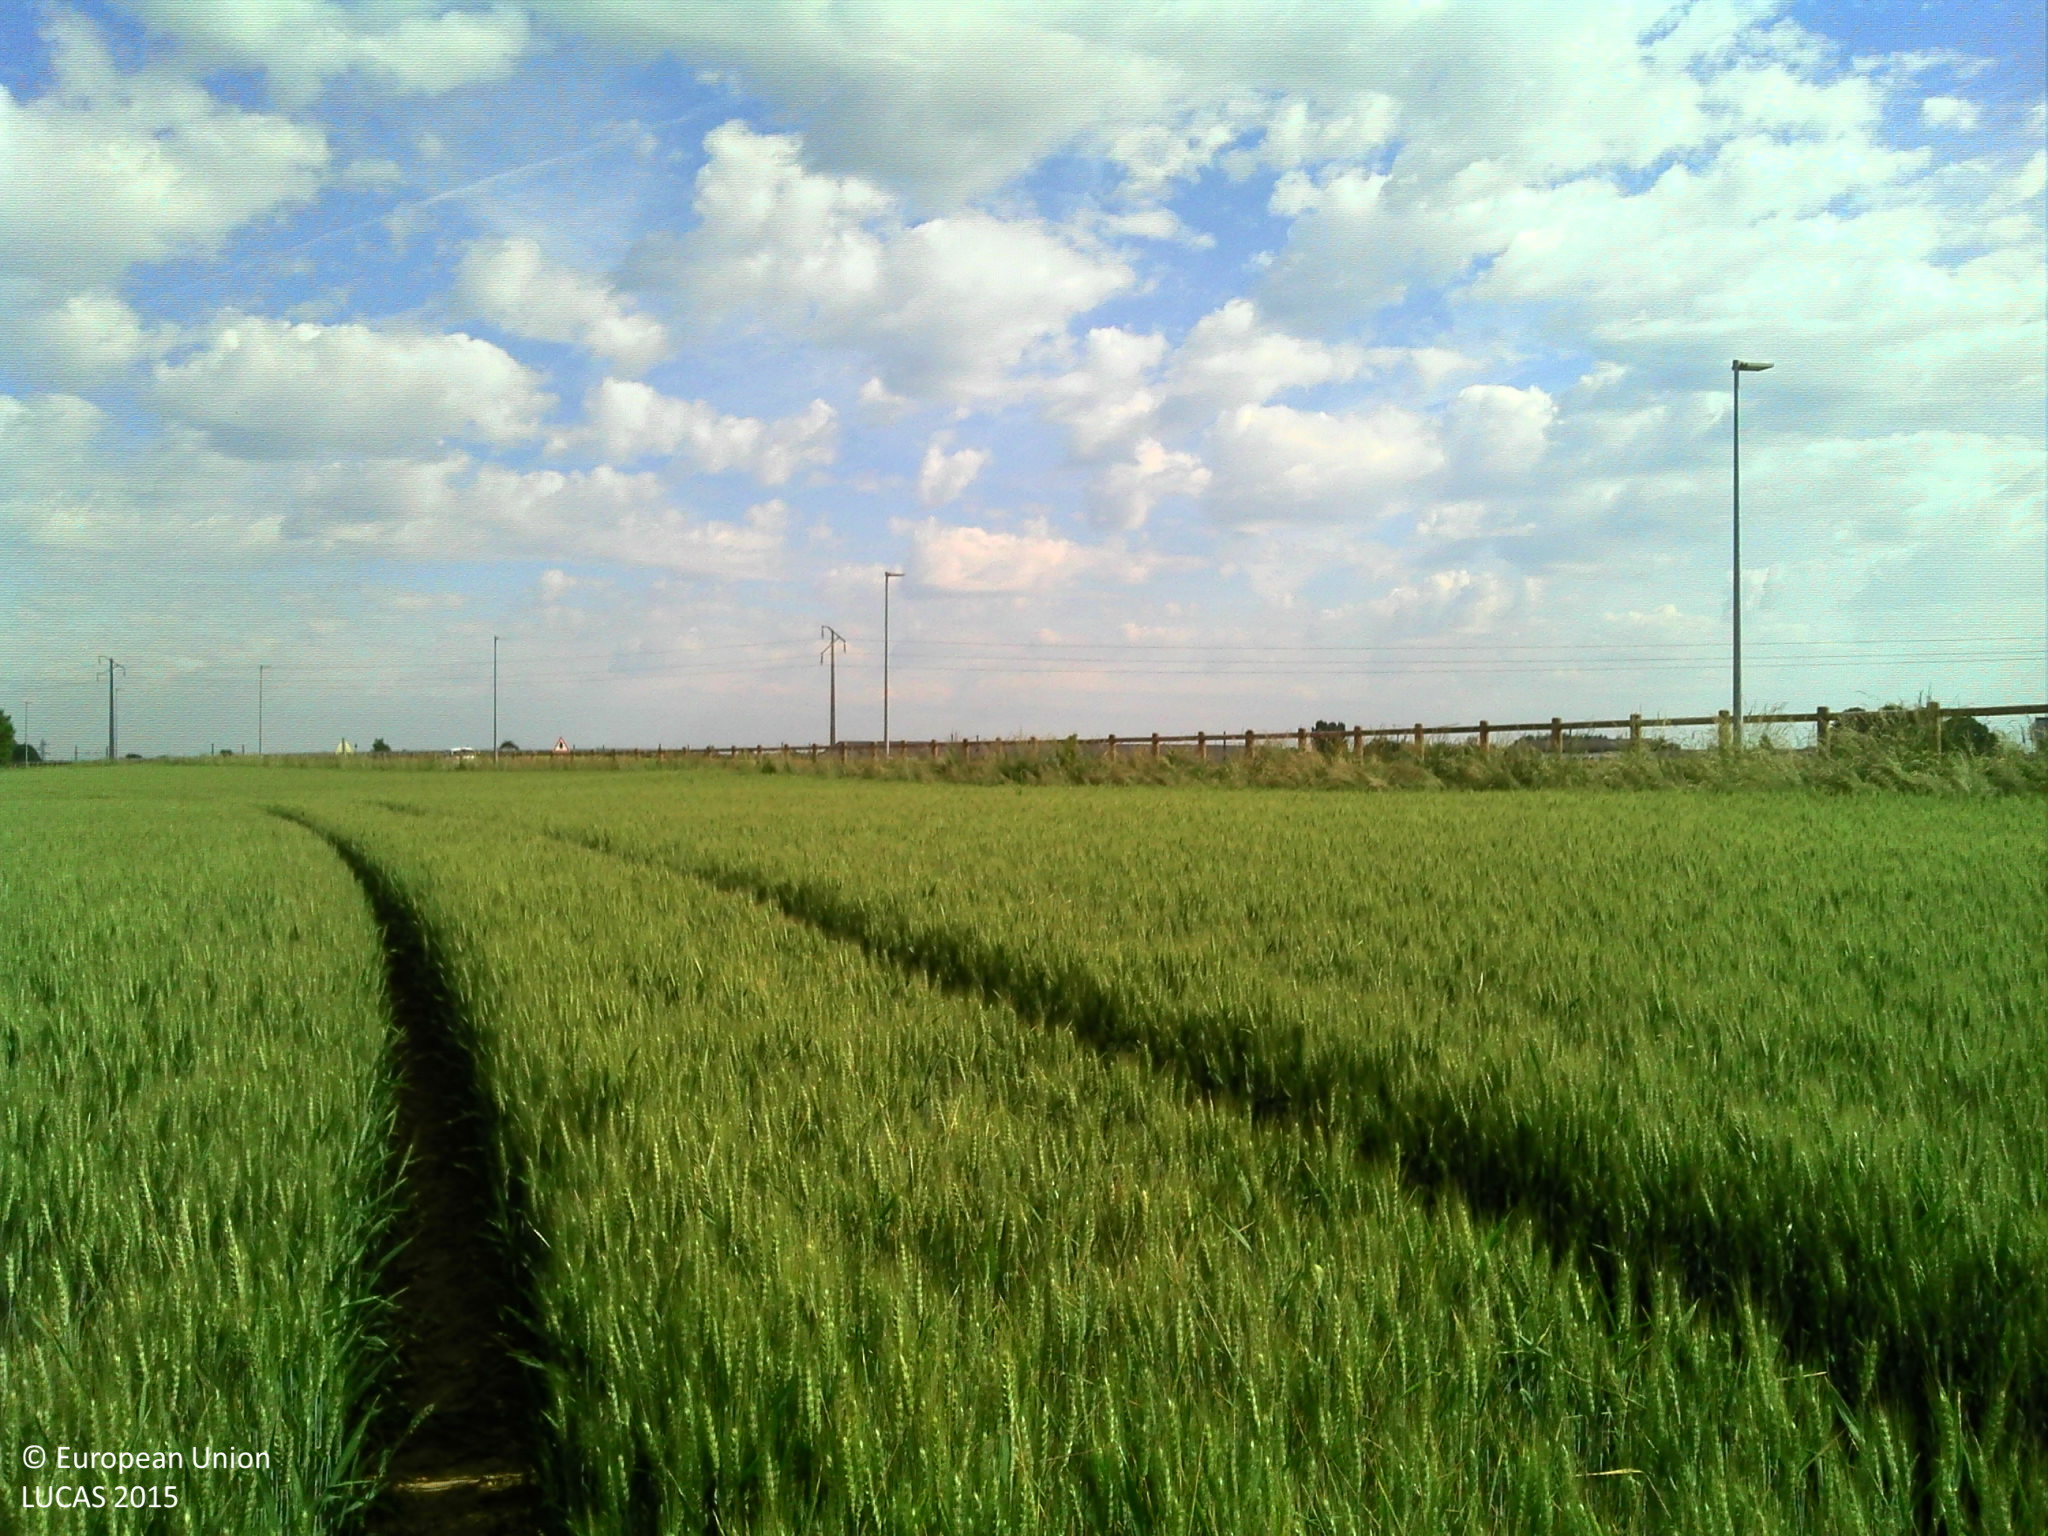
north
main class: Cropland
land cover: Common wheat
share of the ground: > 75 %
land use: Agriculture (excluding fallow land and kitchen gardens)
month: May
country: FR
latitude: 47.2202
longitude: 5.2603
